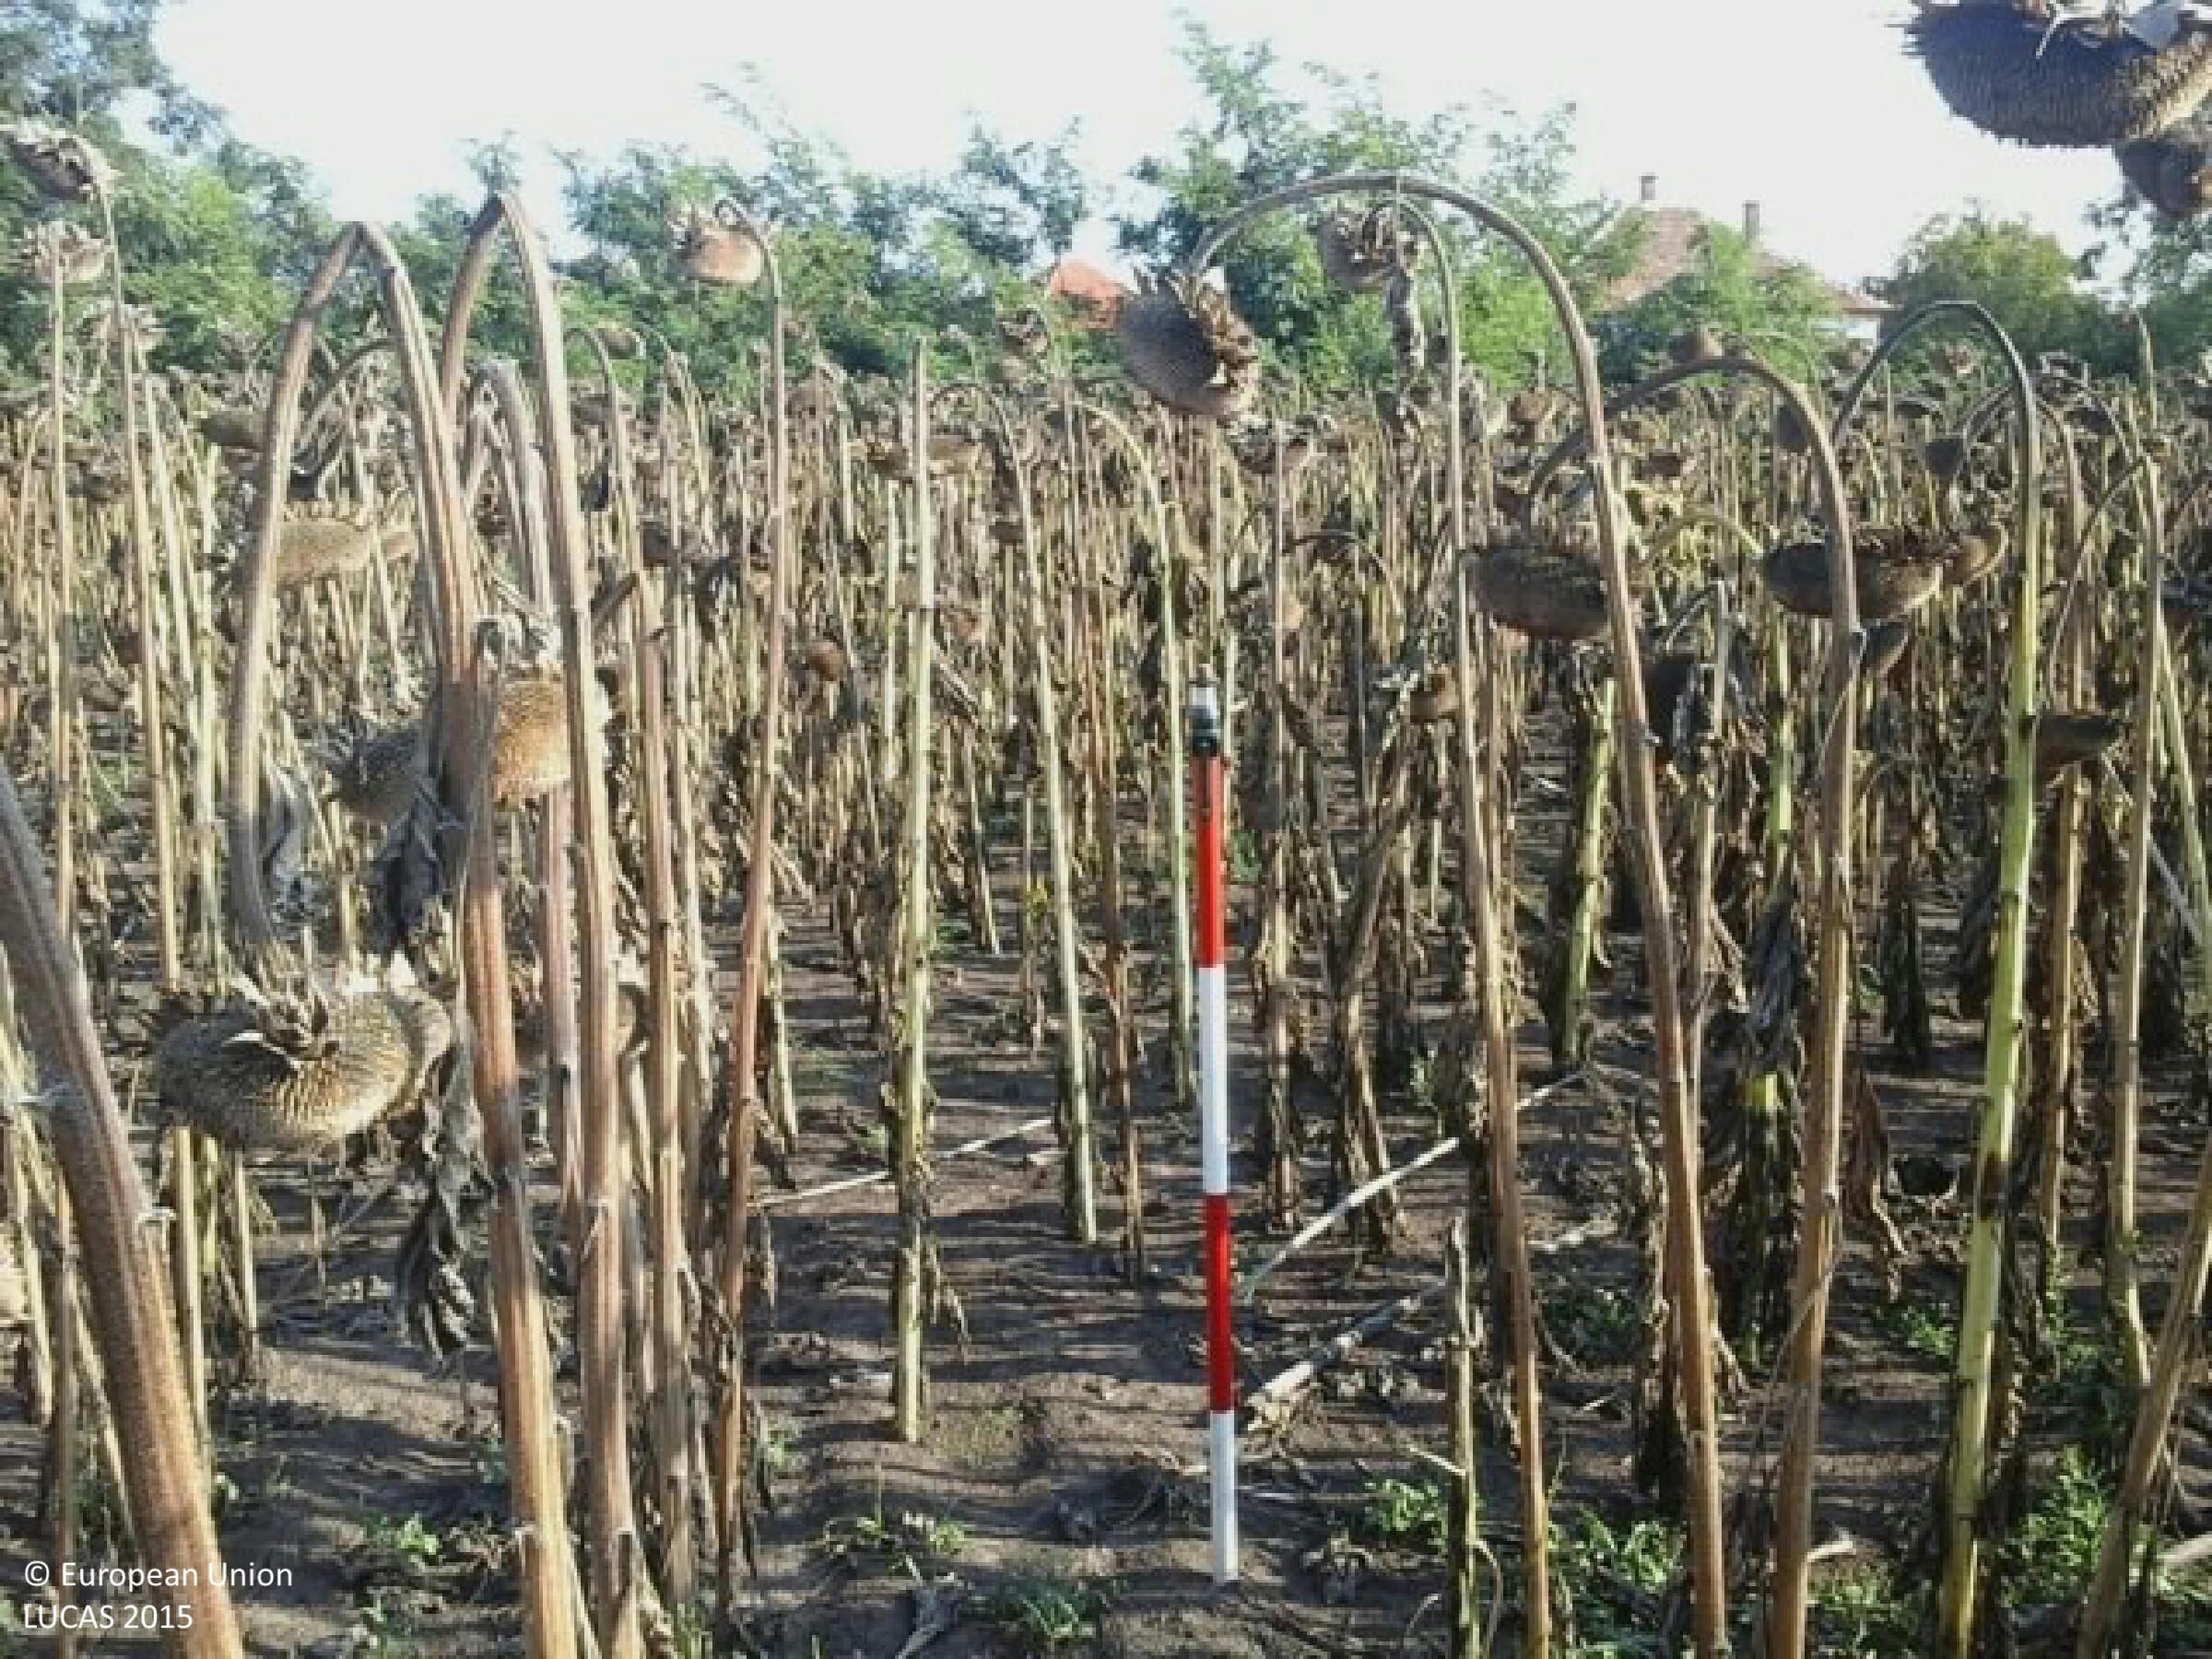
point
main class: Cropland
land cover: Sunflower
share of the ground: 50 - 75 %
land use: Agriculture (excluding fallow land and kitchen gardens)
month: September
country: HU
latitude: 47.6556
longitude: 19.8378
